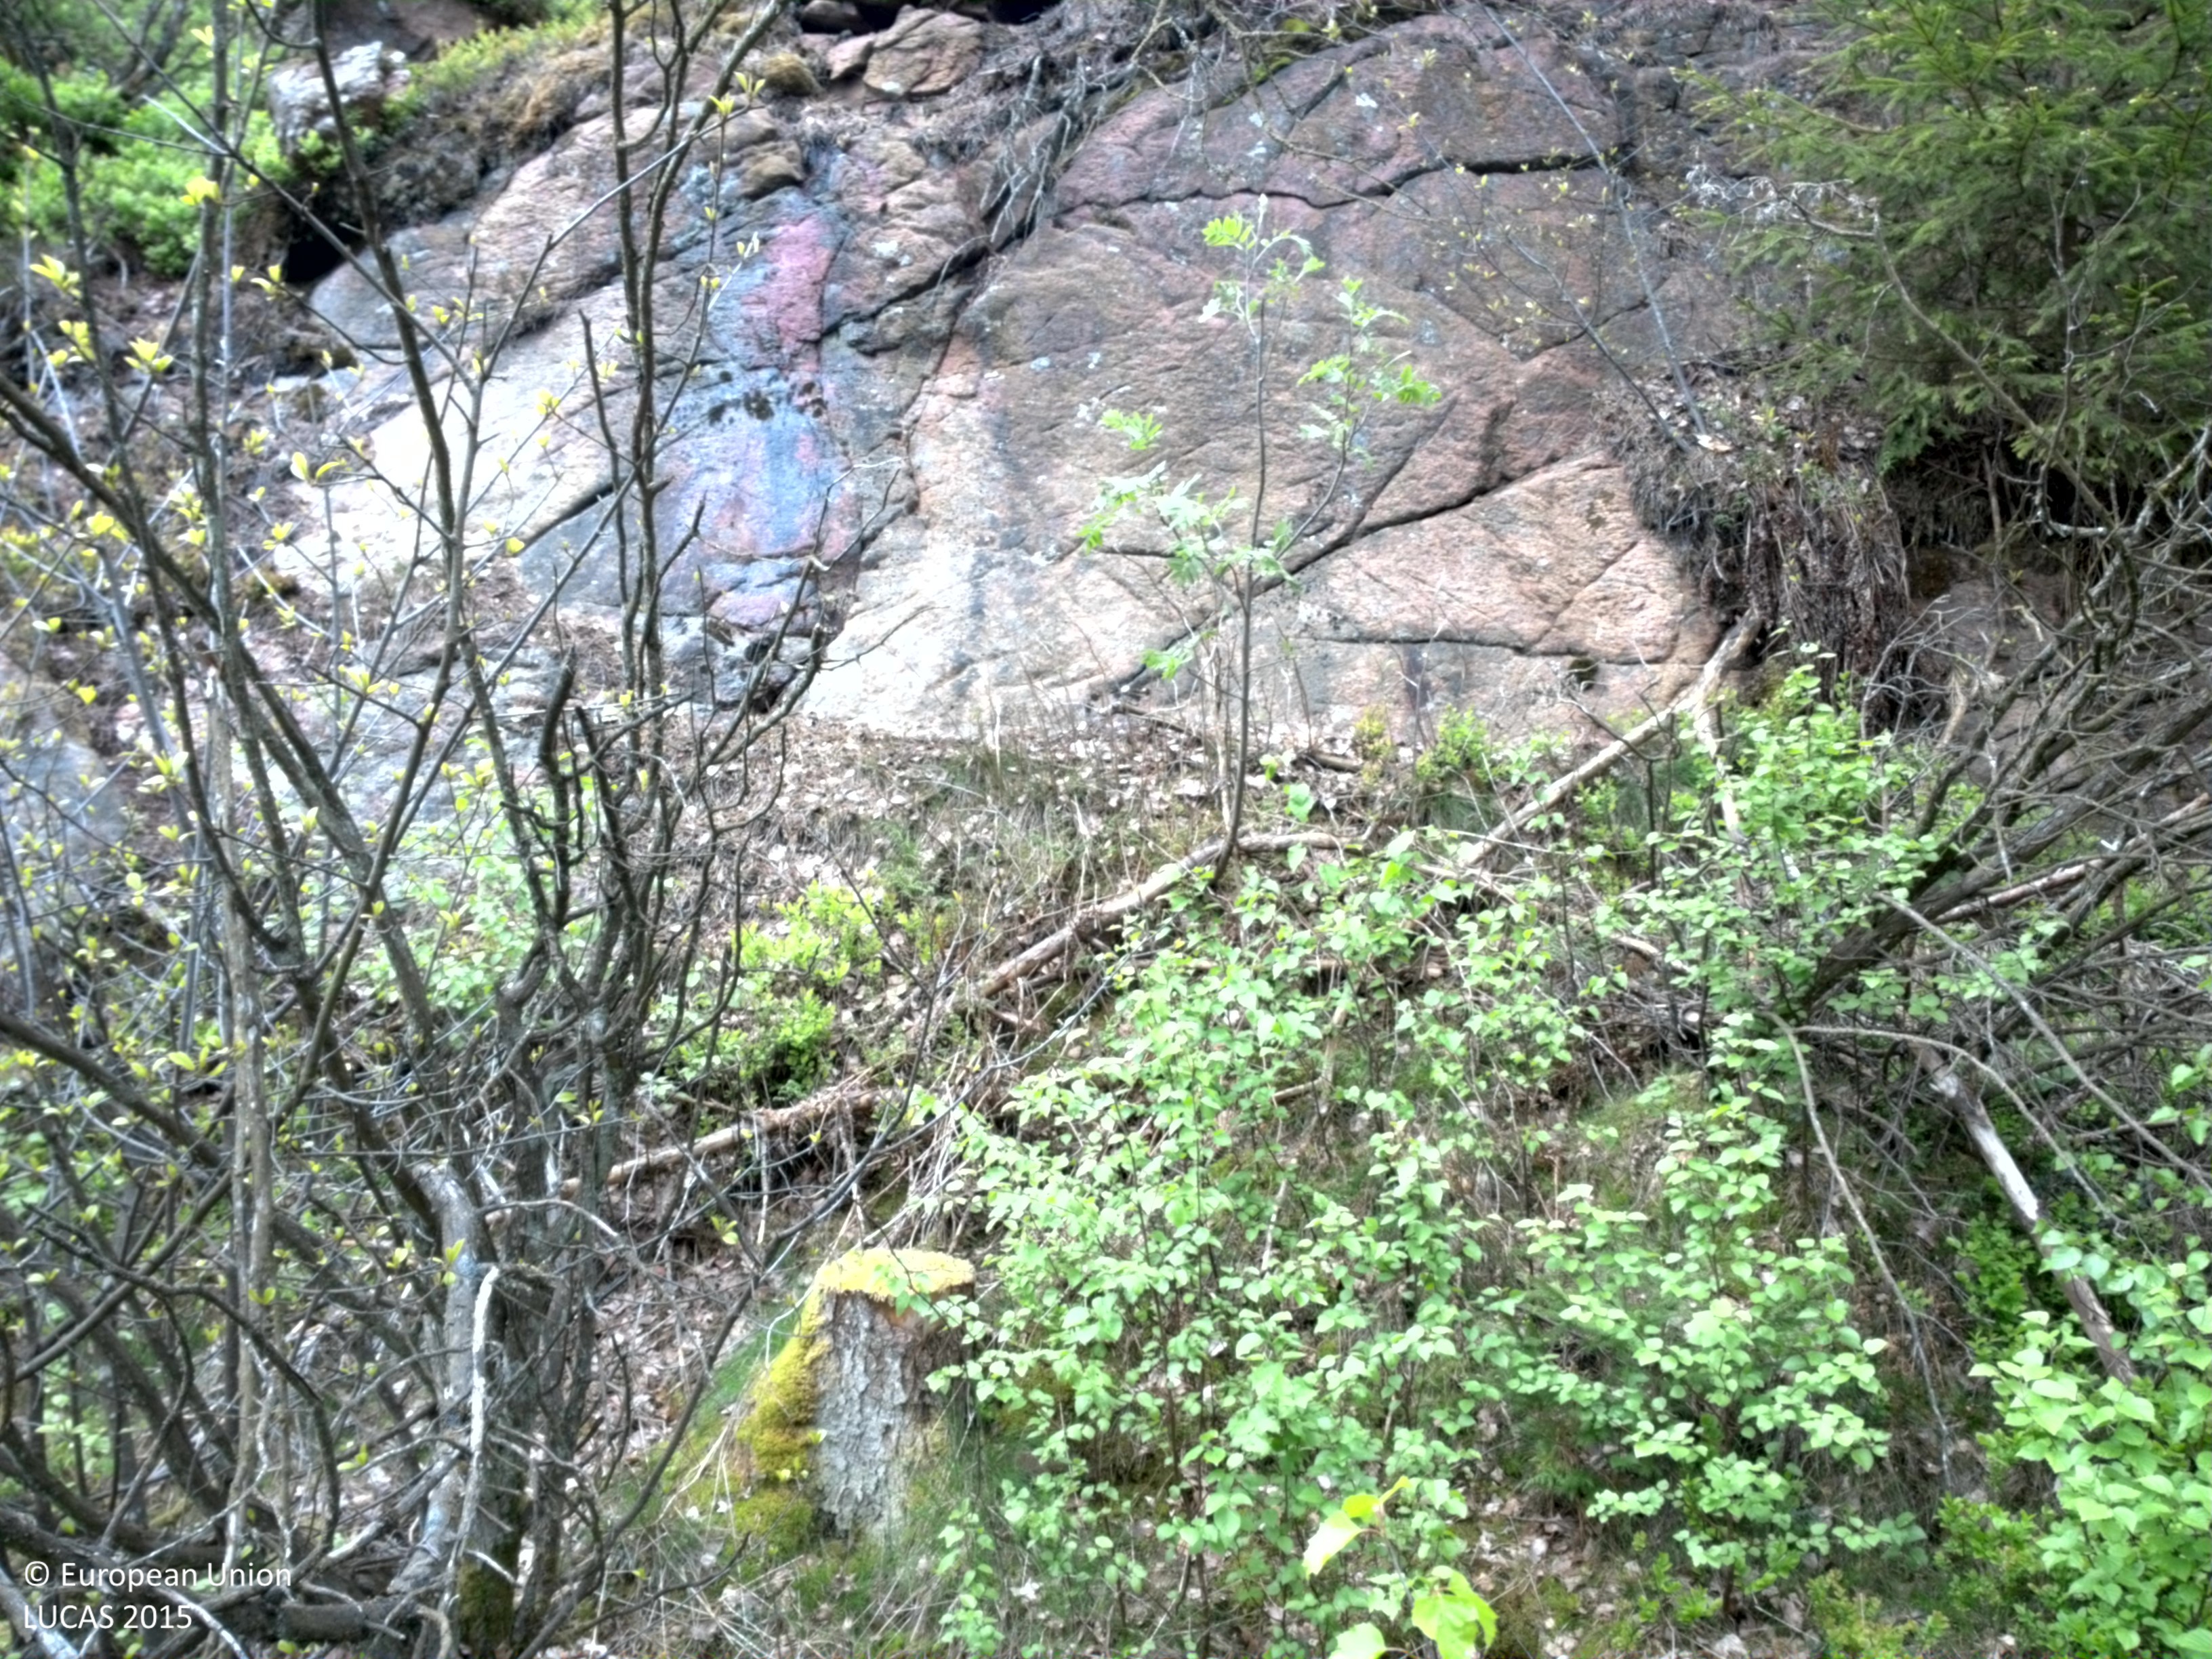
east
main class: Shrubland
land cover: Shrubland with sparse tree cover
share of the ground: > 75 %
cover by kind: herbaceous plants 55 %, shrubs 40 %, coniferous forest trees 5 %
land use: Forestry
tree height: < 5 m
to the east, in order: Shrubland with sparse tree cover; Rock outcrops; Pine dominated mixed woodland; Broadleaved woodland; Tracks; Spruce dominated coniferous woodland; Broadleaved woodland
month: May
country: SE
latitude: 57.7734
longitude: 11.9638
